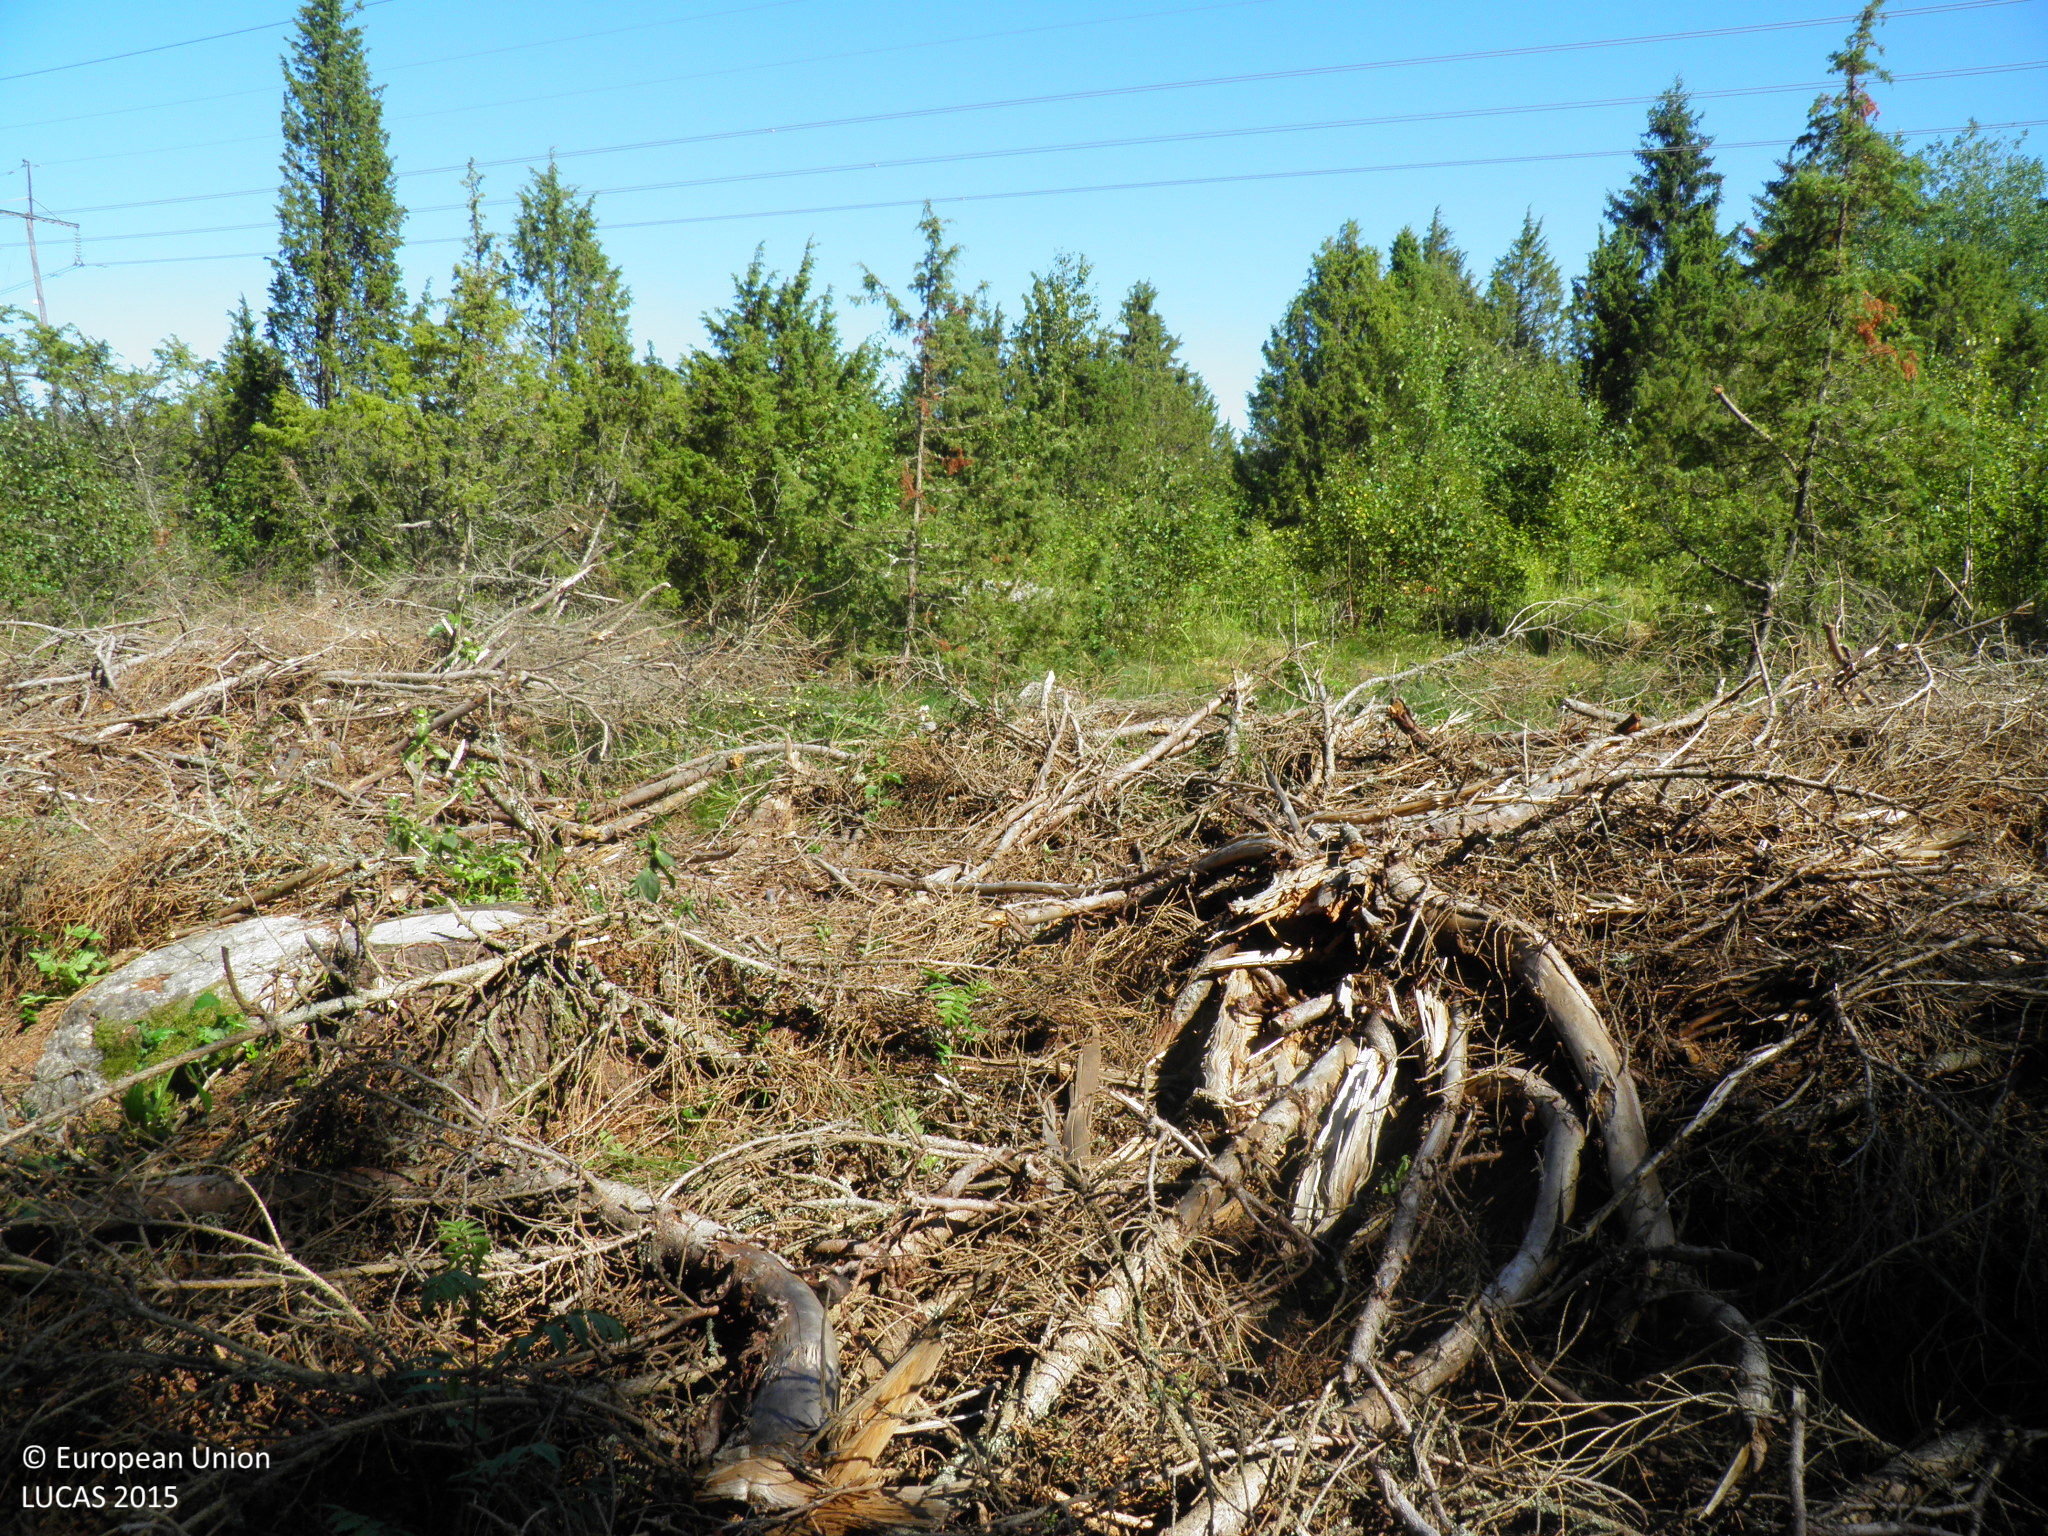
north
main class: Grassland
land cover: Spontaneously vegetated surfaces
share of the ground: 10 - 25 %
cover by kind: unconsolidated bare surface 70 %, herbaceous plants 15 %, shrubs 5 %
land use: Forestry
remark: Clear cut
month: August
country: FI
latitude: 60.7694
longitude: 21.6779
